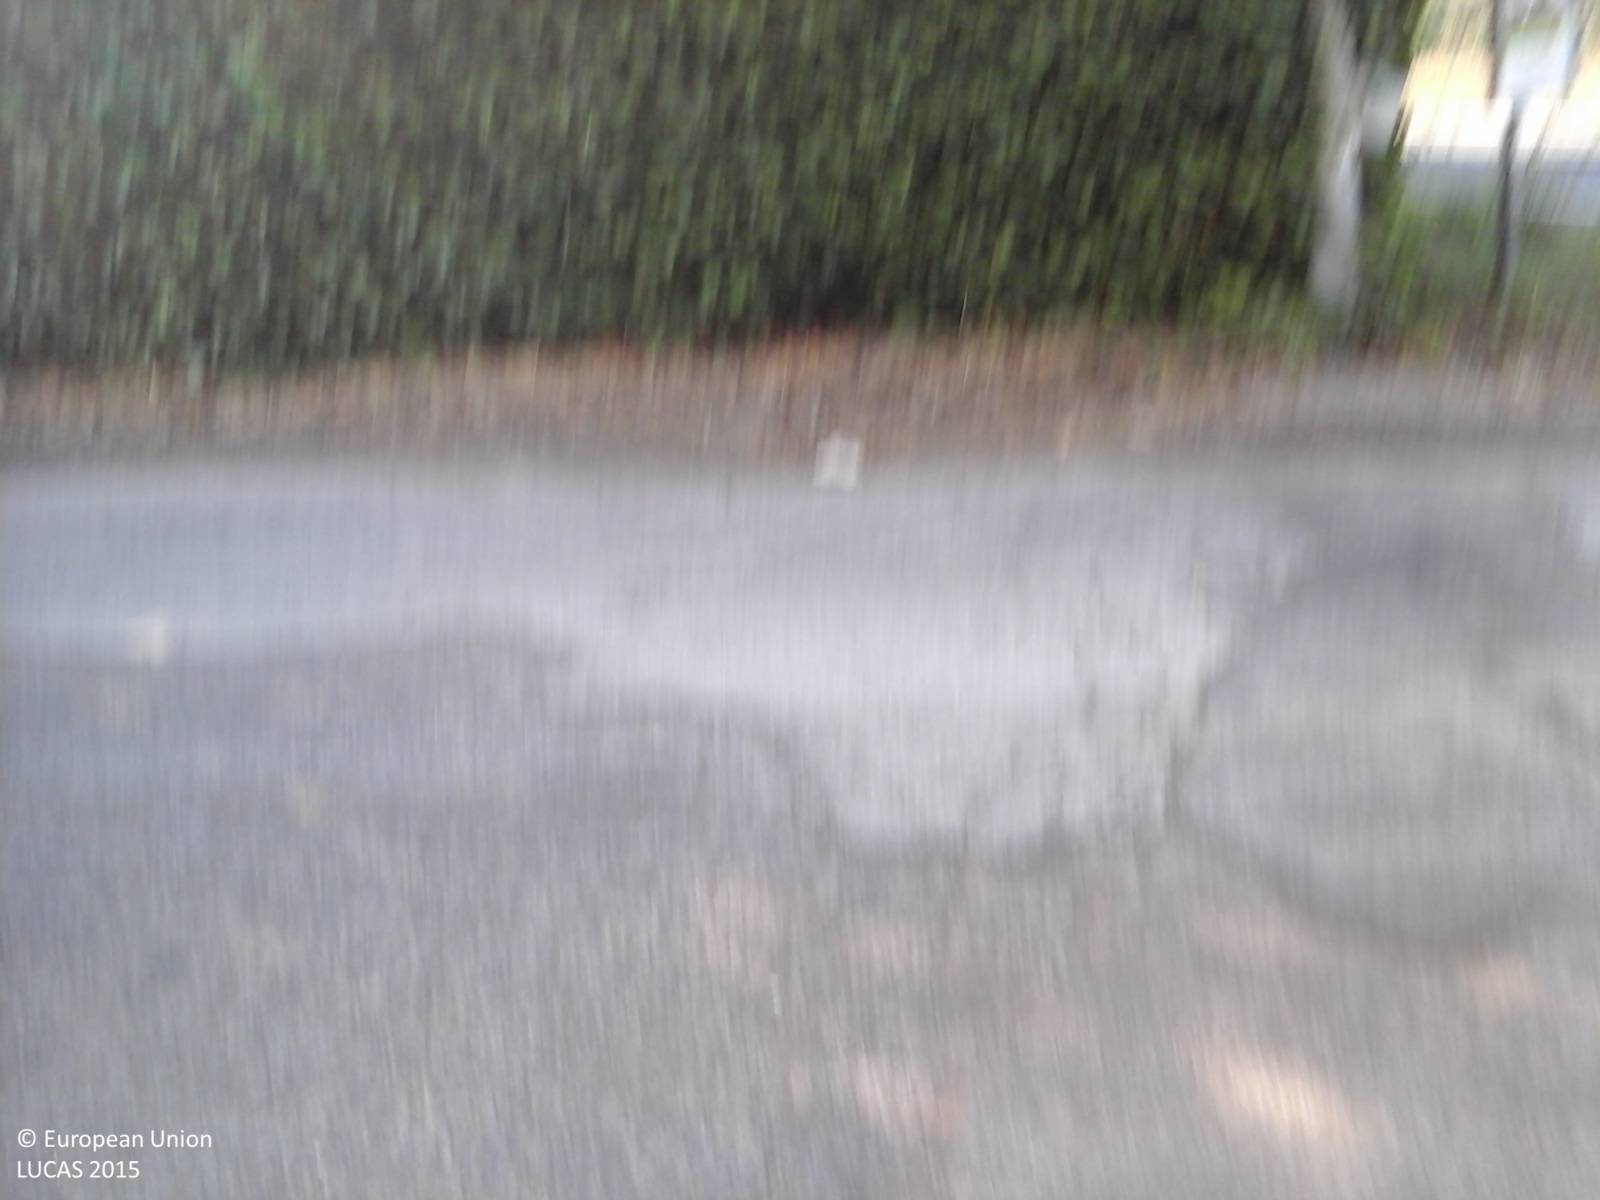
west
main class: Cropland
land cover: Olive groves
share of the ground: > 75 %
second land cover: Spontaneously vegetated surfaces
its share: > 75 %
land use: Agriculture (excluding fallow land and kitchen gardens)
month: August
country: IT
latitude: 42.1266
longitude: 12.0852
